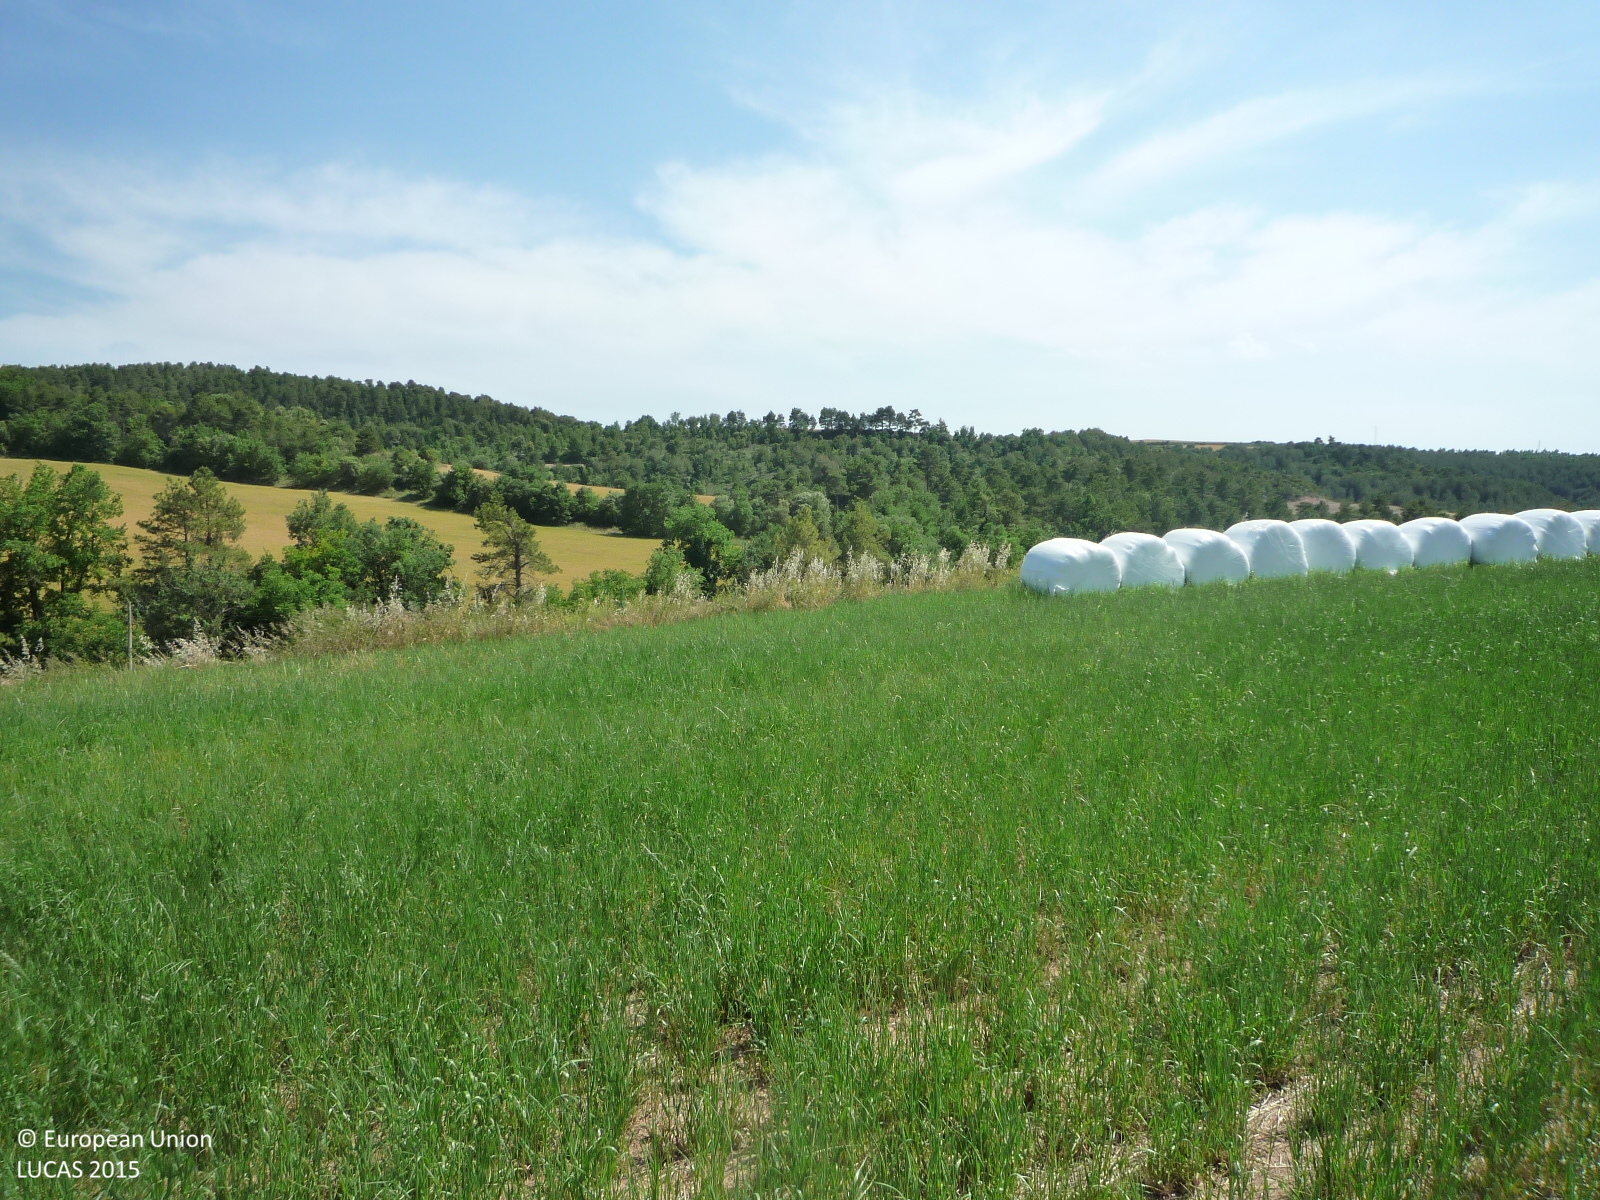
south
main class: Cropland
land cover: Temporary grasslands
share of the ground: > 75 %
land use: Agriculture (excluding fallow land and kitchen gardens)
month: May
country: ES
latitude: 41.8978
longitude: 1.9506
